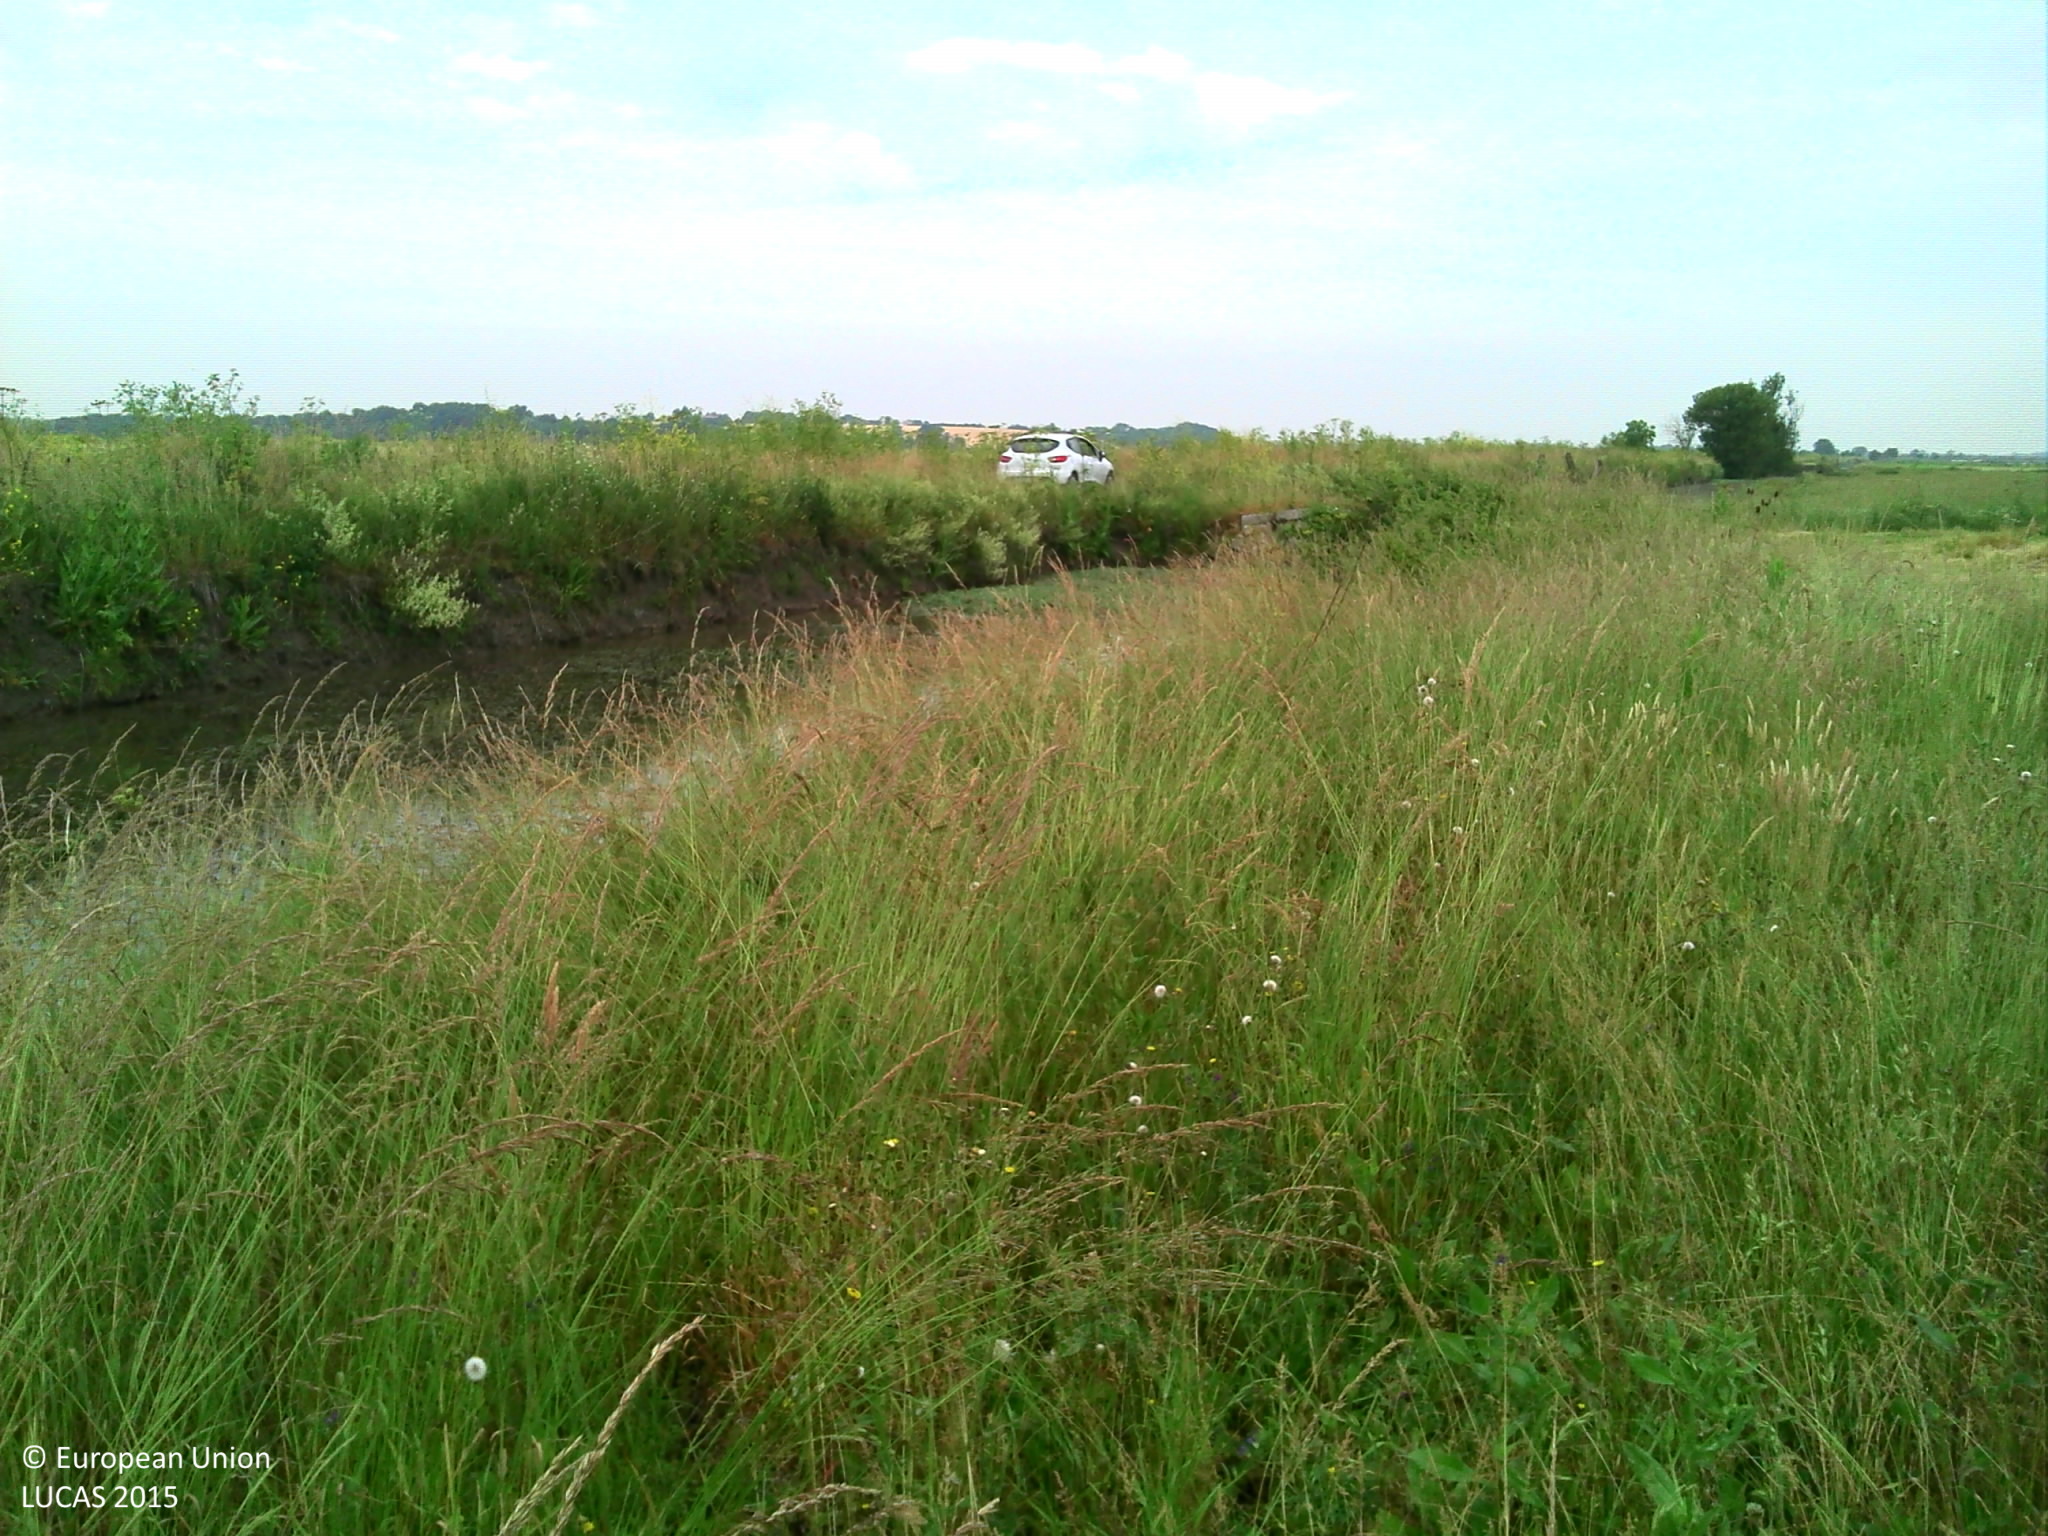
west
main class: Grassland
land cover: Grassland without tree/shrub cover
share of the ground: > 75 %
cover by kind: herbaceous plants 95 %, shrubs 5 %
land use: Agriculture (excluding fallow land and kitchen gardens)
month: June
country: FR
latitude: 46.0089
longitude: -0.9154
